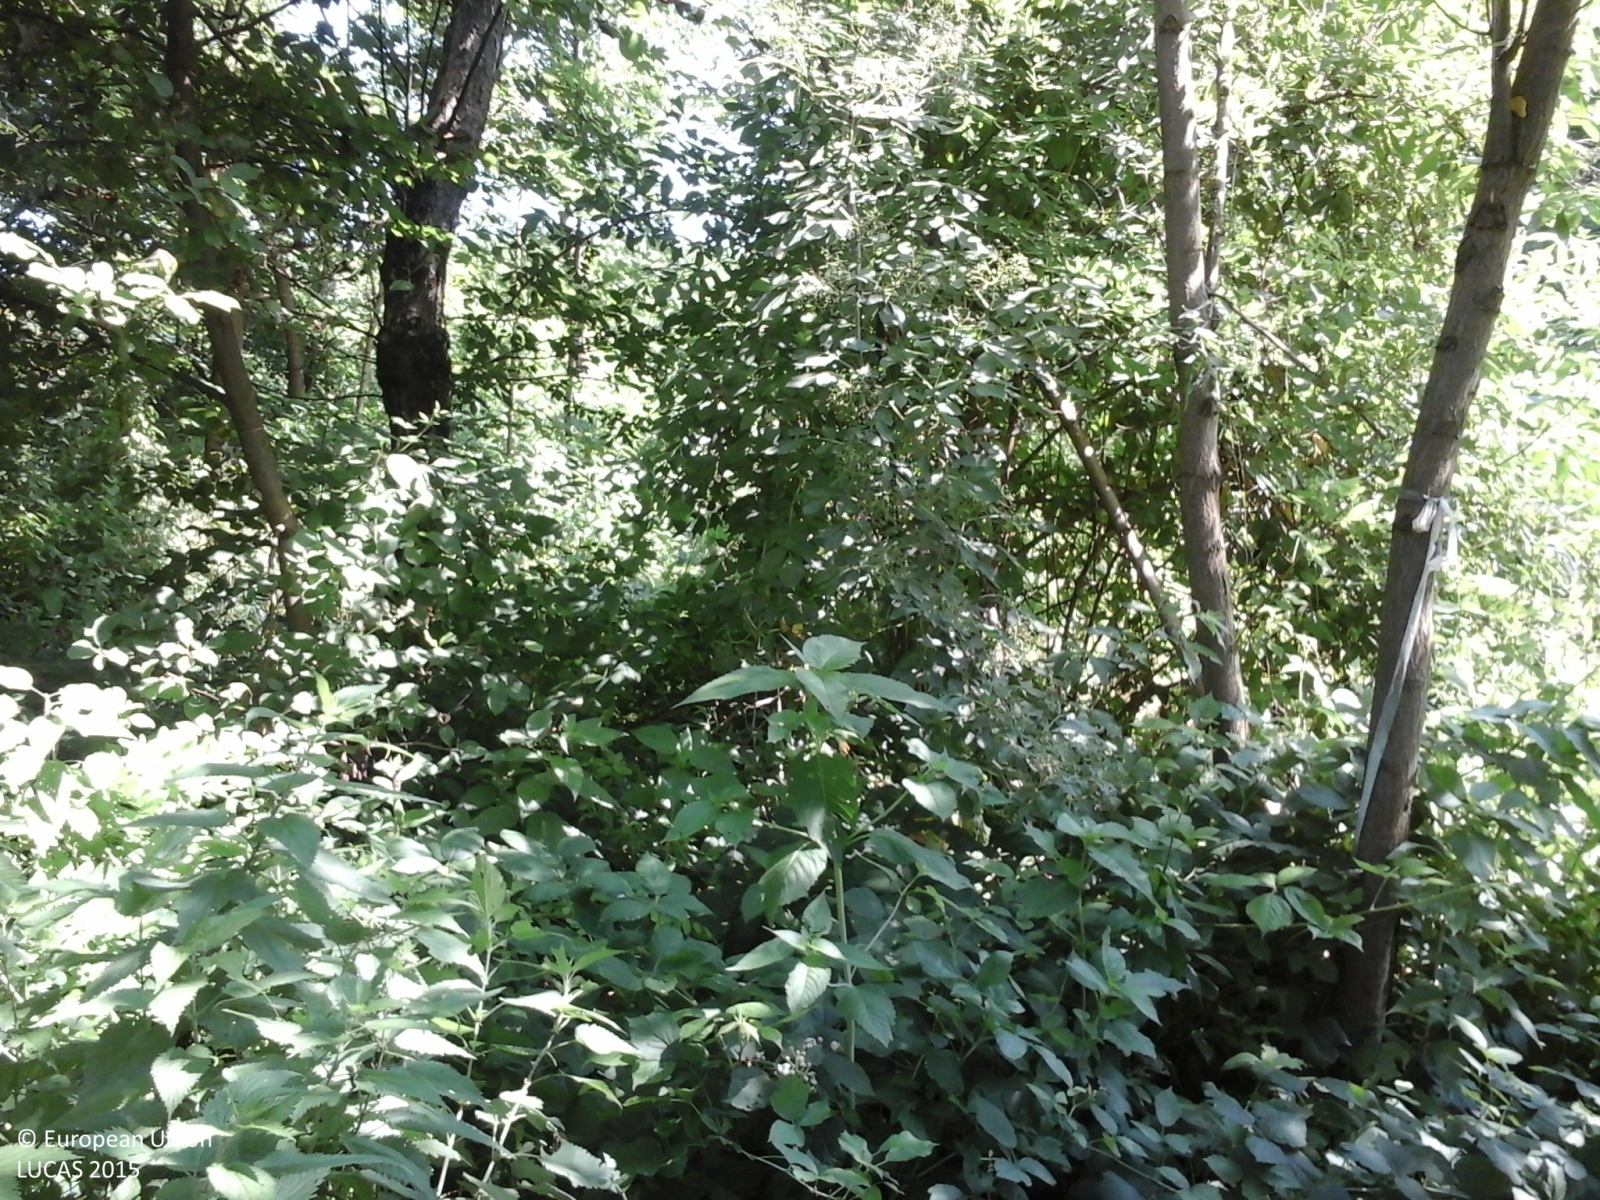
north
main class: Woodland
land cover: Broadleaved woodland
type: thermophilous deciduous forest
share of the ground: > 75 %
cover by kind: broadleaved forest trees 85 %, herbaceous plants 10 %, shrubs 5 %
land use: Forestry
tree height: > 5 m
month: June
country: IT
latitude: 44.4154
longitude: 7.7066
